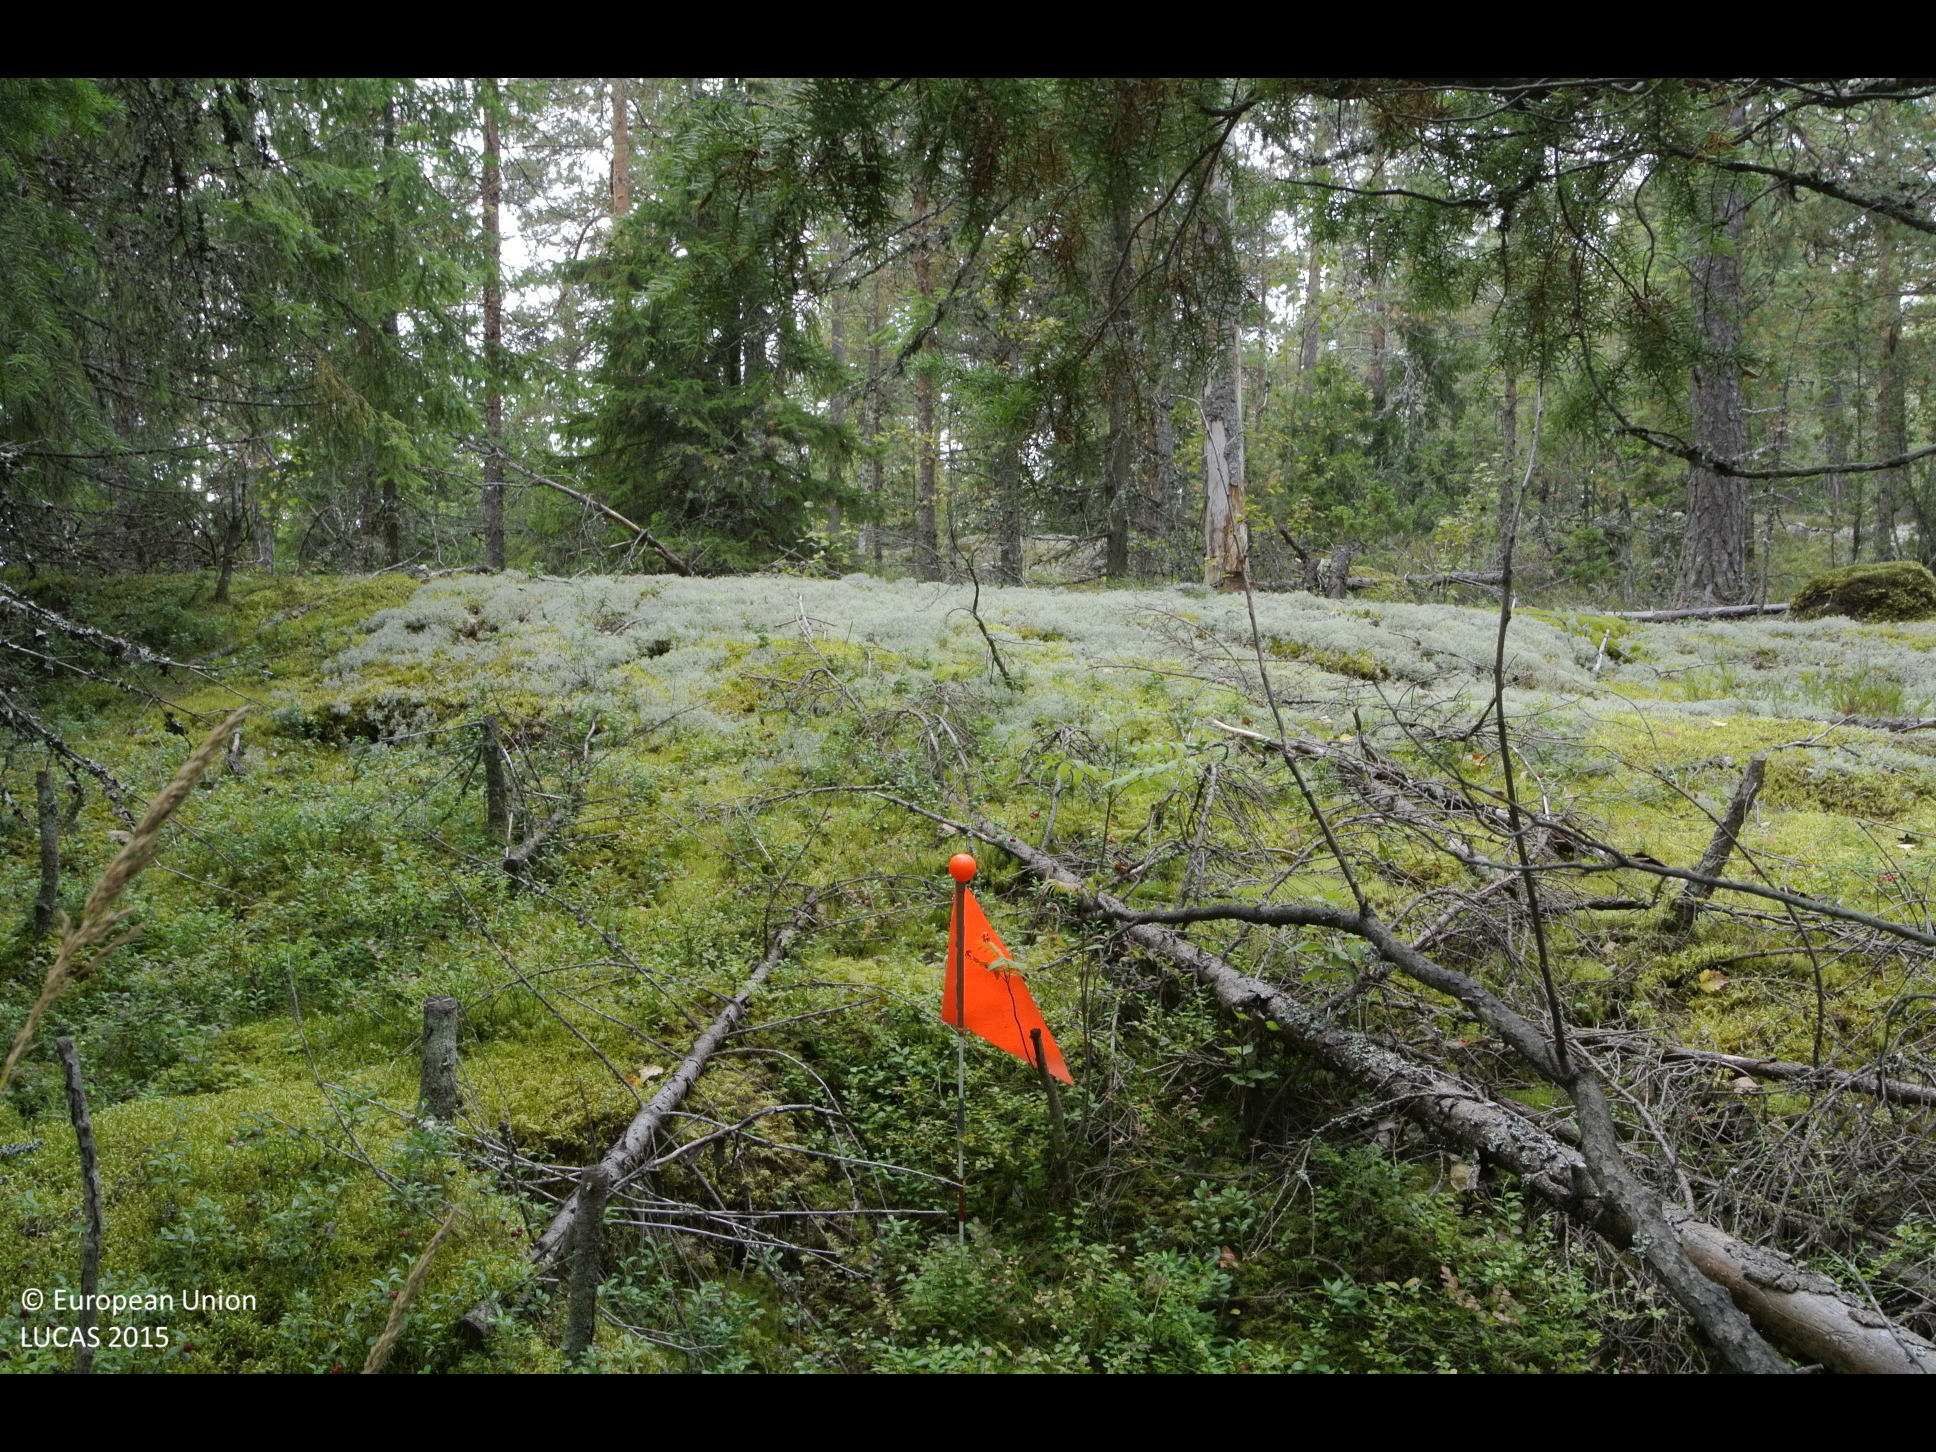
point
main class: Woodland
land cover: Spruce dominated coniferous woodland
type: boreal forest
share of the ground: > 75 %
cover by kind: coniferous forest trees 80 %, broadleaved forest trees 5 %, shrubs 5 %, lichens and mosses 5 %
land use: Forestry
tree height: > 5 m
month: September
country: FI
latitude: 60.4772
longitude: 25.3160
